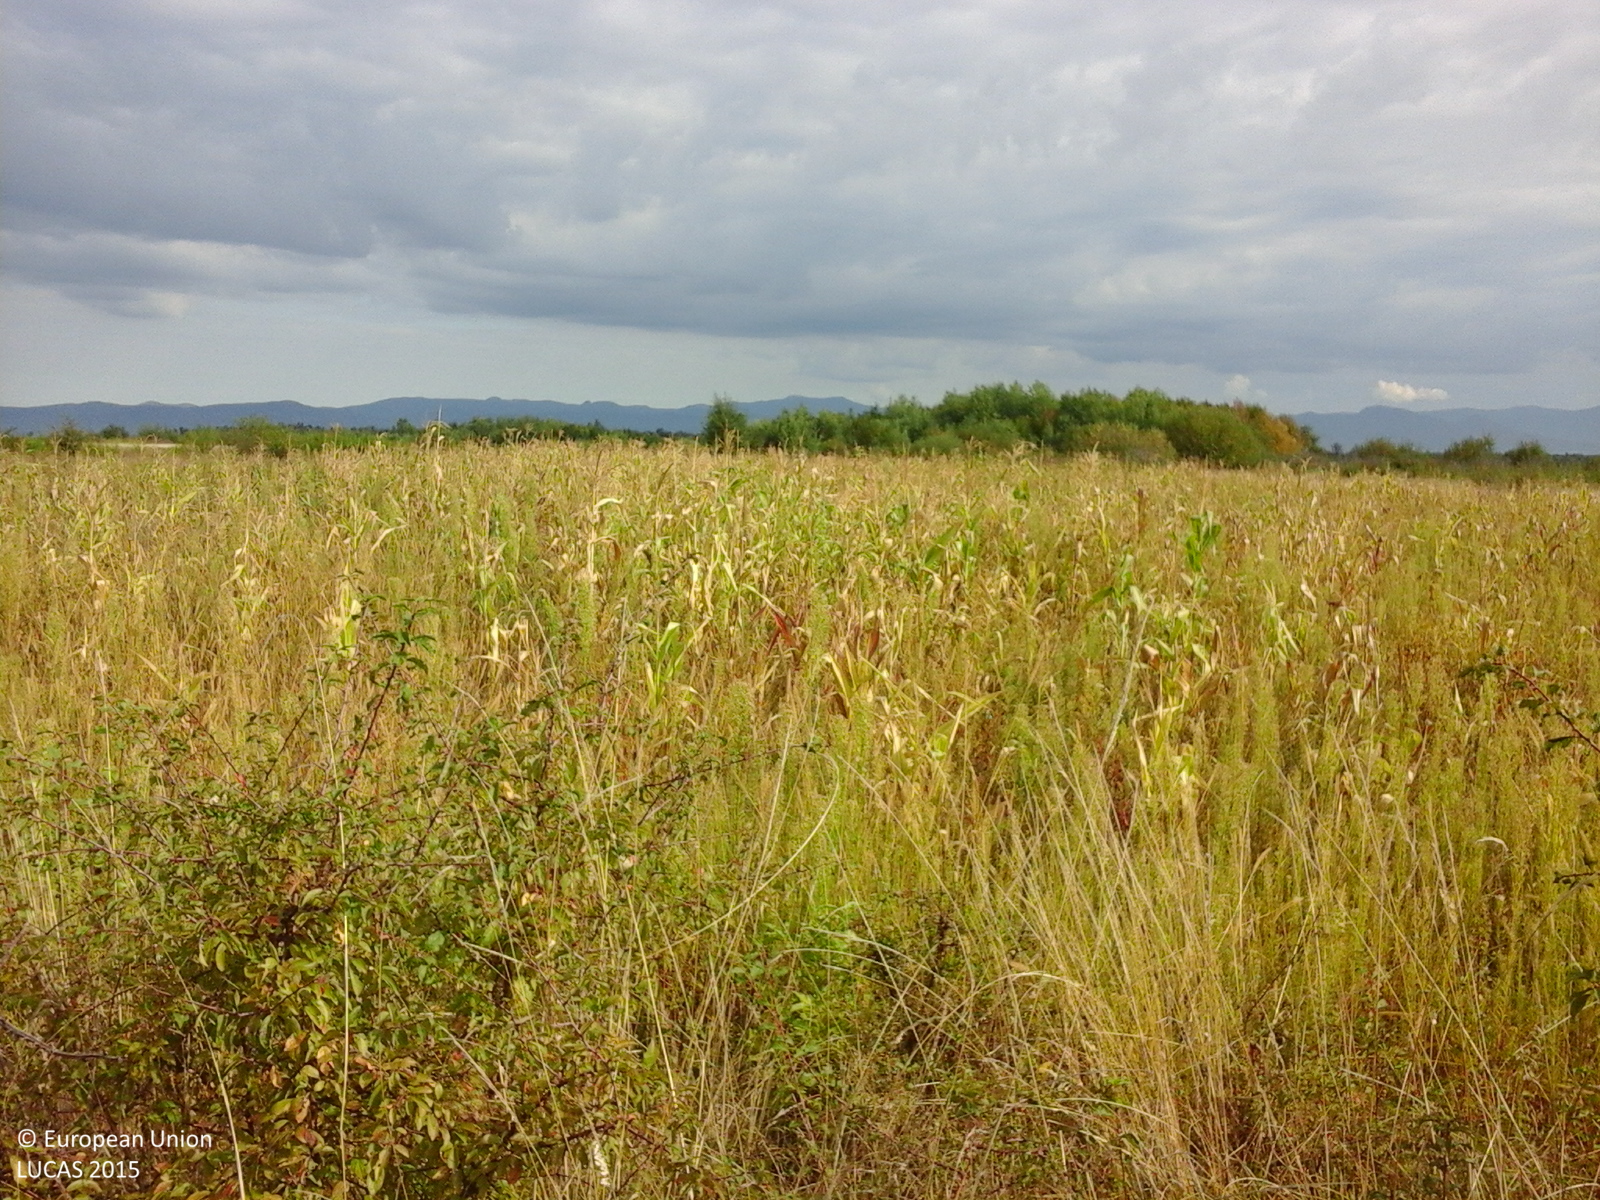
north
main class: Shrubland
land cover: Shrubland with sparse tree cover
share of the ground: > 75 %
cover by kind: herbaceous plants 85 %, shrubs 10 %, broadleaved forest trees 5 %
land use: Fallow land
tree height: < 5 m
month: September
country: RO
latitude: 47.5548
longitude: 23.4824
